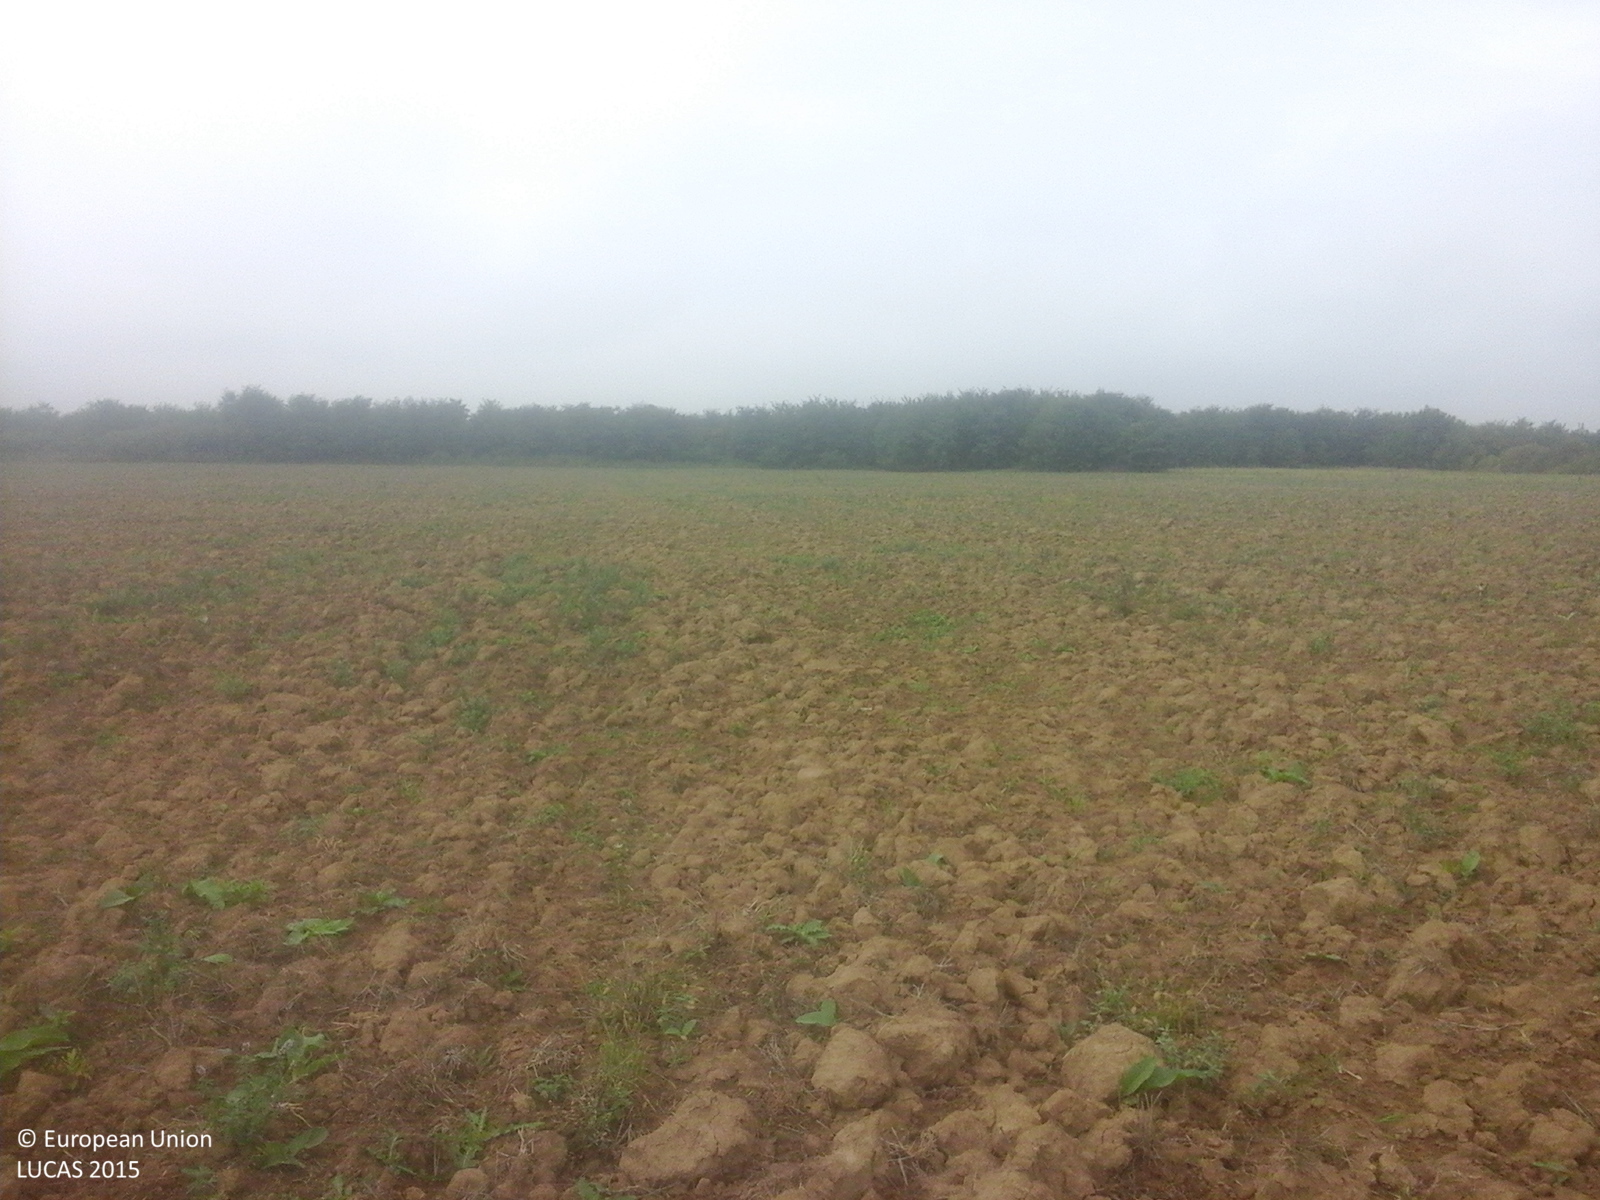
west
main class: Cropland
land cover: Maize
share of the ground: < 10 %
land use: Agriculture (excluding fallow land and kitchen gardens)
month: September
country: RO
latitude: 45.8456
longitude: 22.0814
